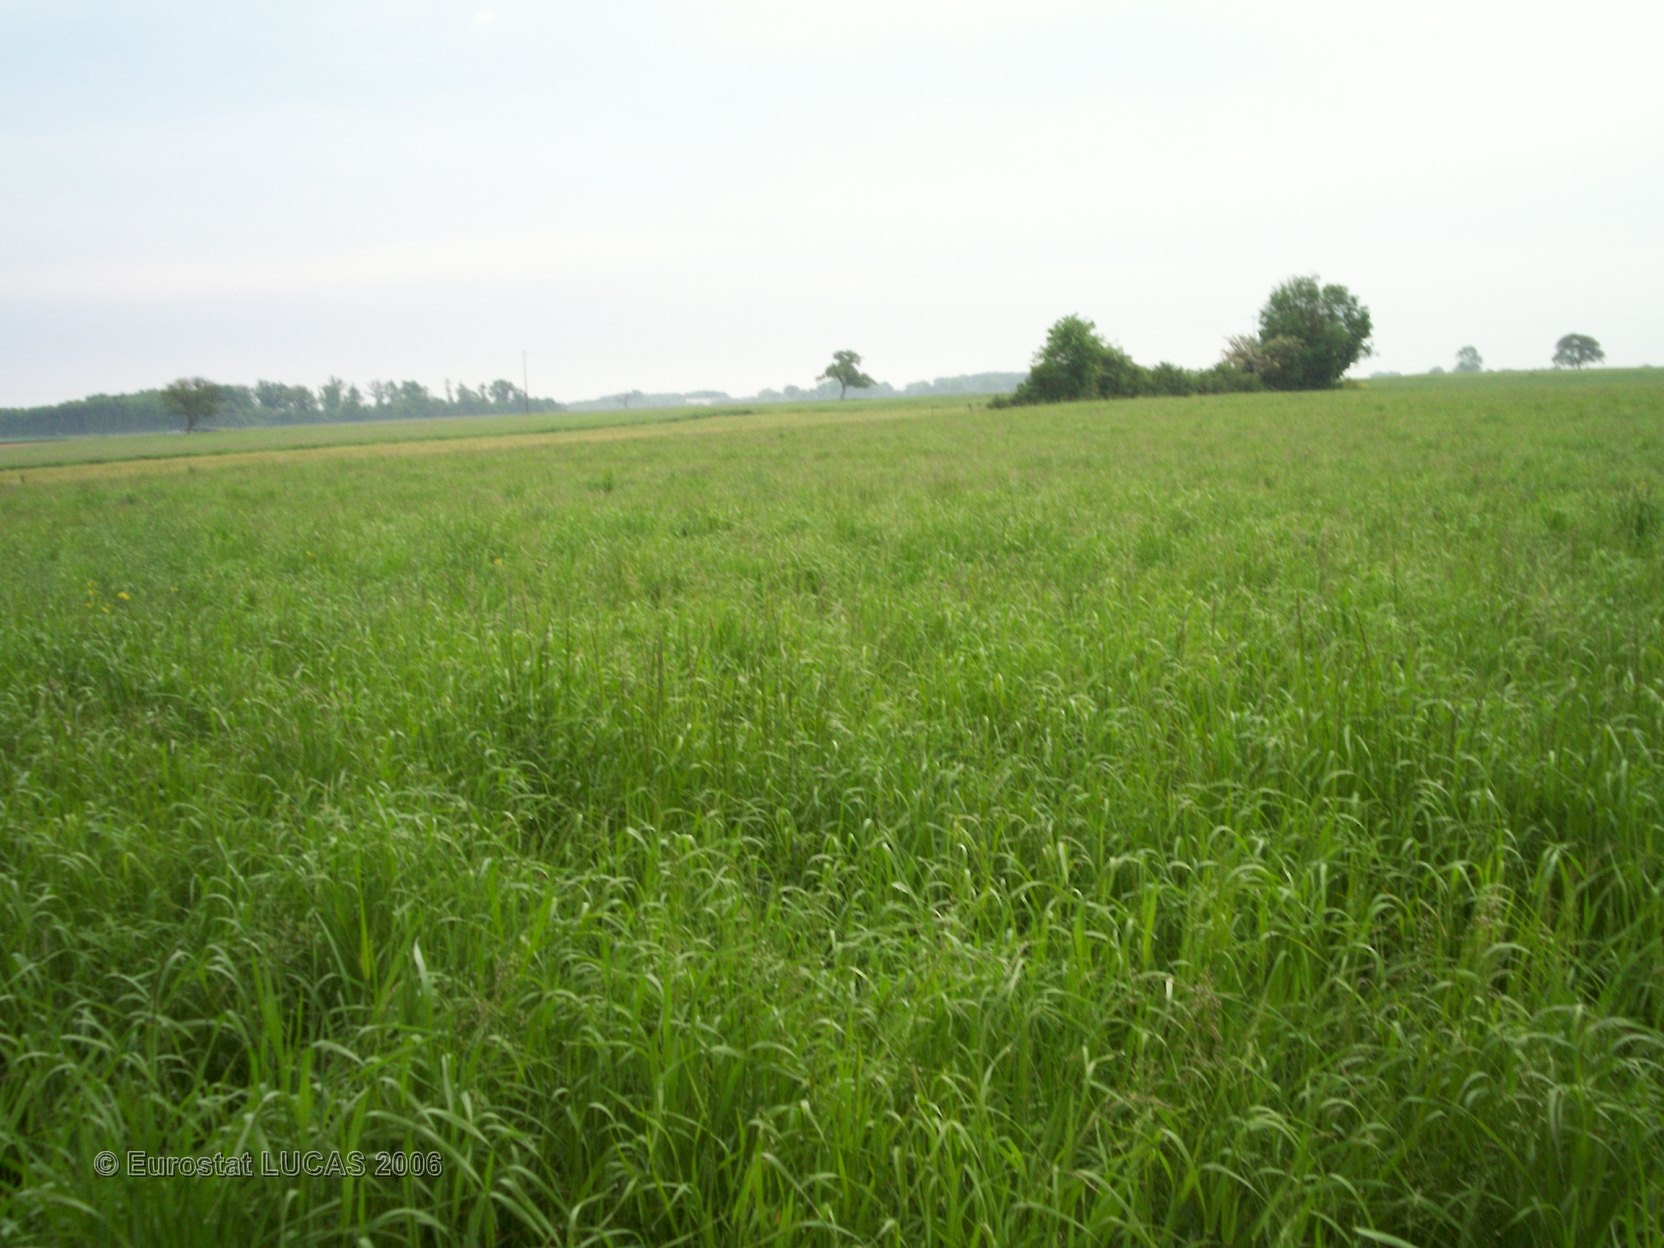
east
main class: Grassland
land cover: Grassland with sparse tree/shrub cover
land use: Agriculture (excluding fallow land and kitchen gardens)
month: May
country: FR
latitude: 46.6646
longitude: 1.0595
